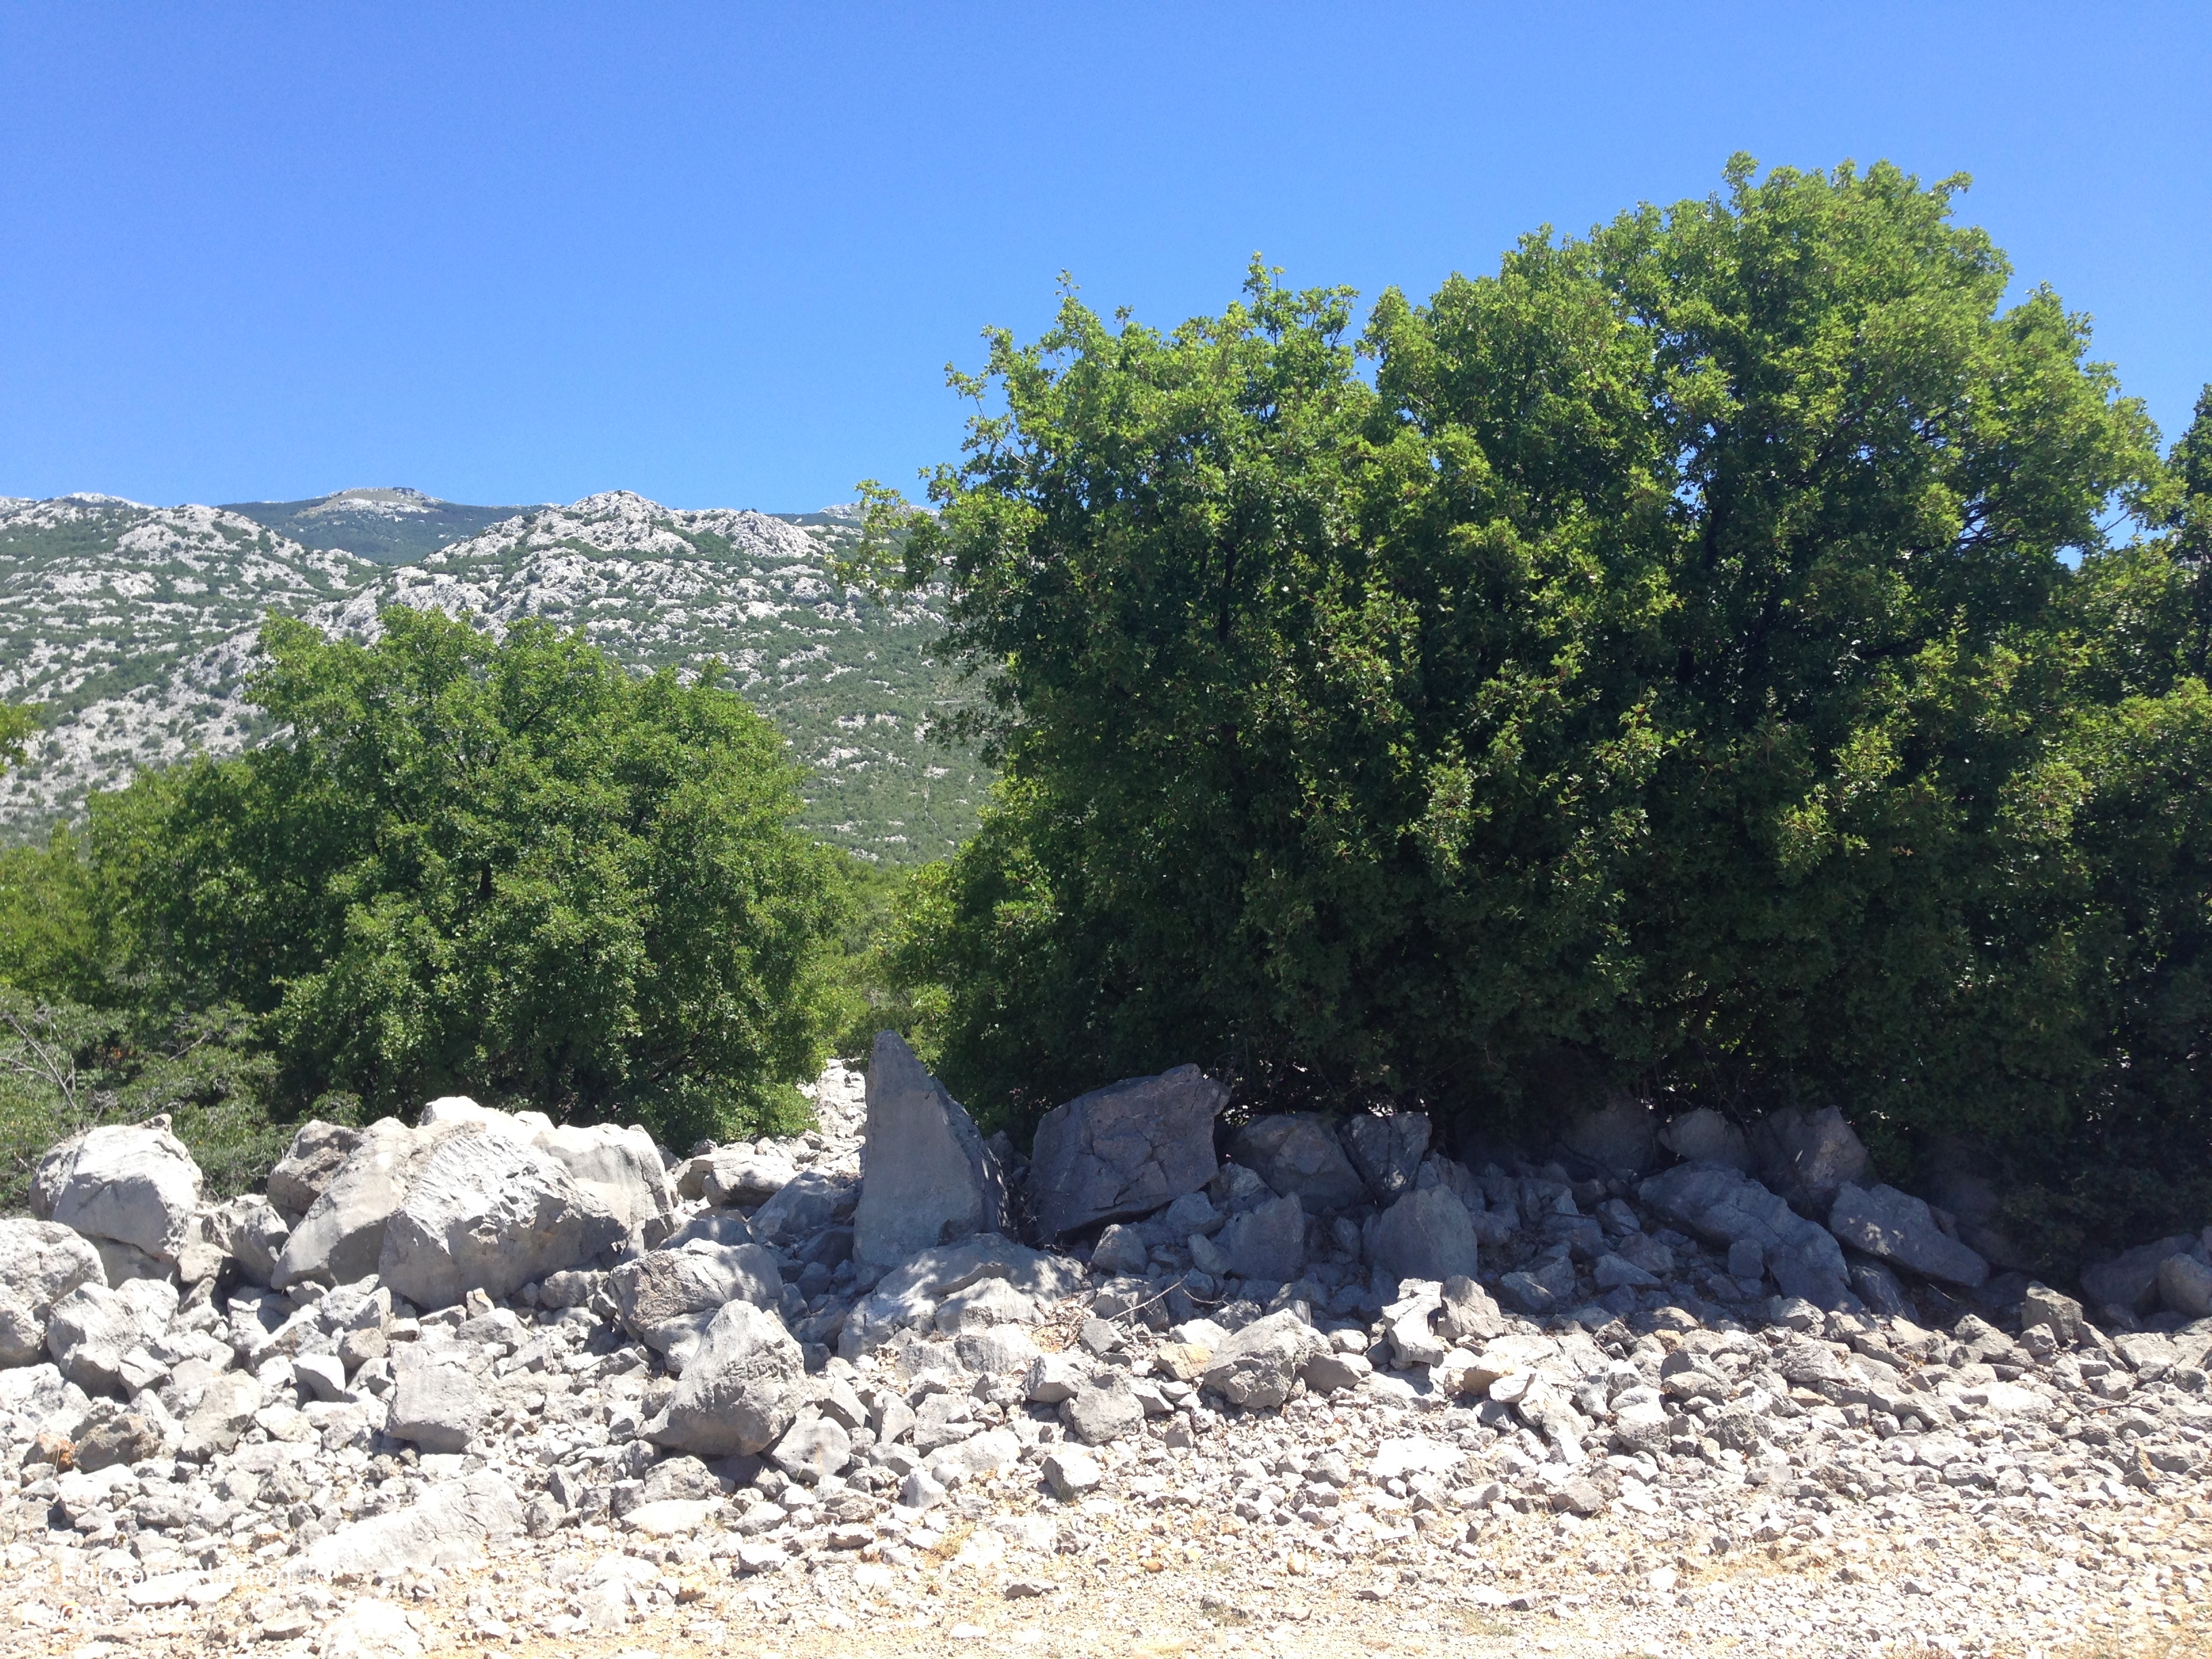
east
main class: Woodland
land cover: Broadleaved woodland
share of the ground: 25 - 50 %
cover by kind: consolidated bare surface 30 %, broadleaved forest trees 25 %, shrubs 20 %, unconsolidated bare surface 20 %, herbaceous plants 5 %
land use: Semi-natural and natural areas not in use
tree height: > 5 m
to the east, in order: Broadleaved woodland; Tracks; Broadleaved woodland; Tracks; Broadleaved woodland; Rocks and stones; Dry stone walls; Broadleaved woodland; Dry stone walls; Broadleaved woodland; Rocks and stones; Broadleaved woodland
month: July
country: HR
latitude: 44.6852
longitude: 14.9268
